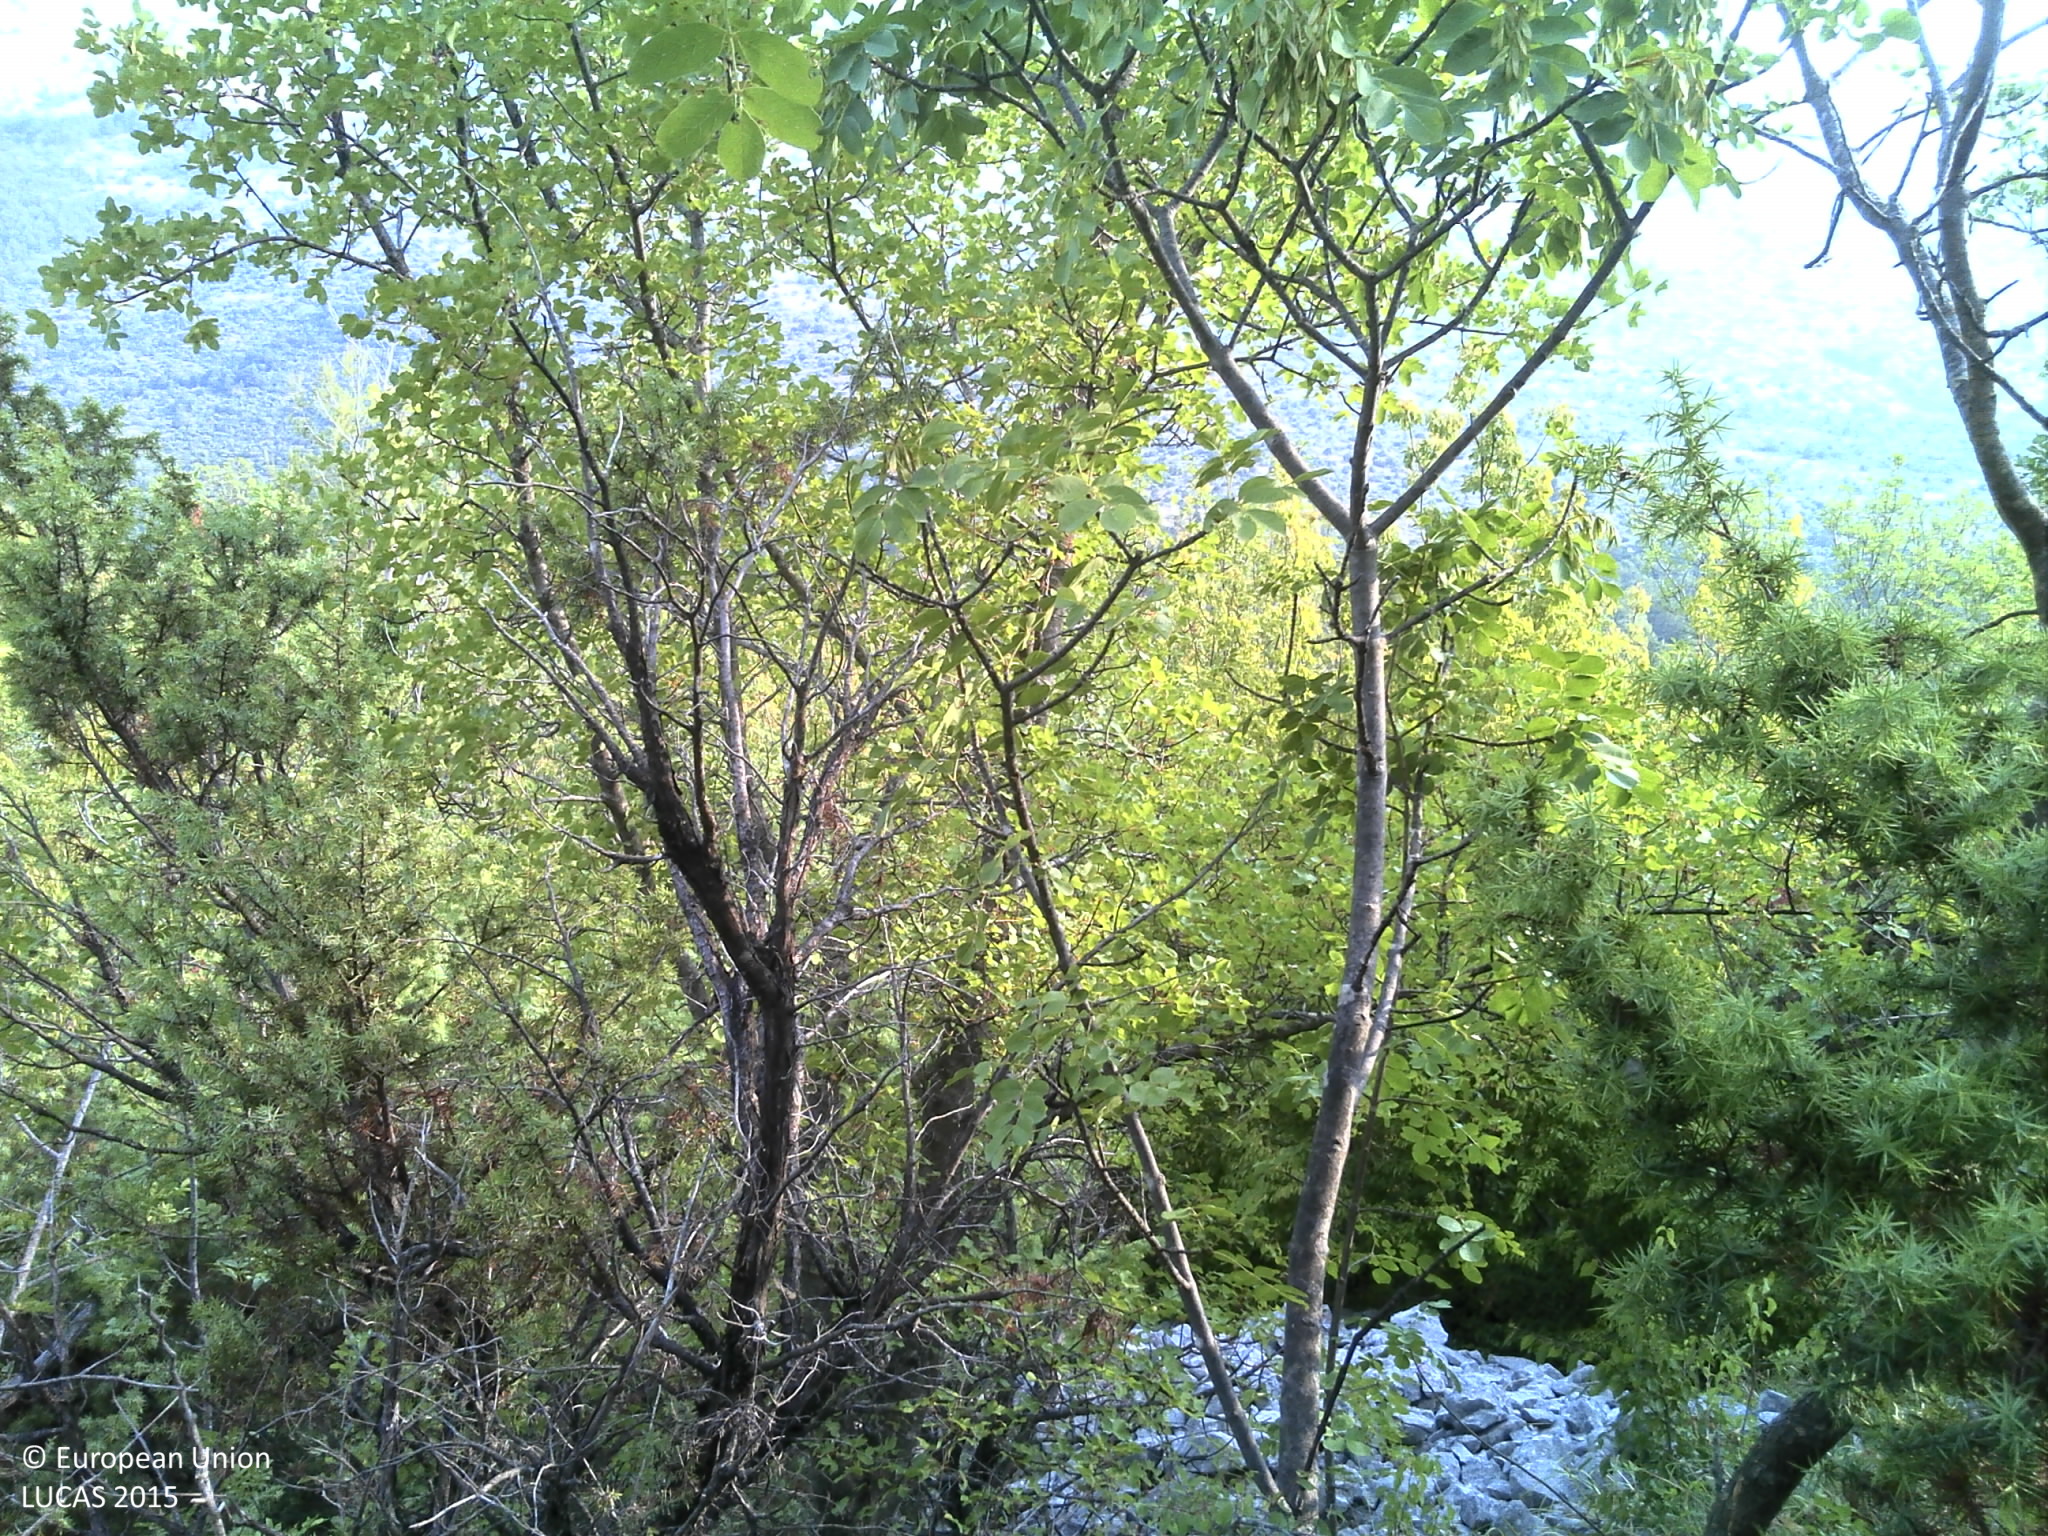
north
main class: Shrubland
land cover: Shrubland with sparse tree cover
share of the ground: > 75 %
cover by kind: shrubs 75 %, herbaceous plants 10 %, consolidated bare surface 10 %, broadleaved forest trees 5 %
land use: Abandoned areas
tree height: < 5 m
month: August
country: HR
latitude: 43.2460
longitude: 17.2452
